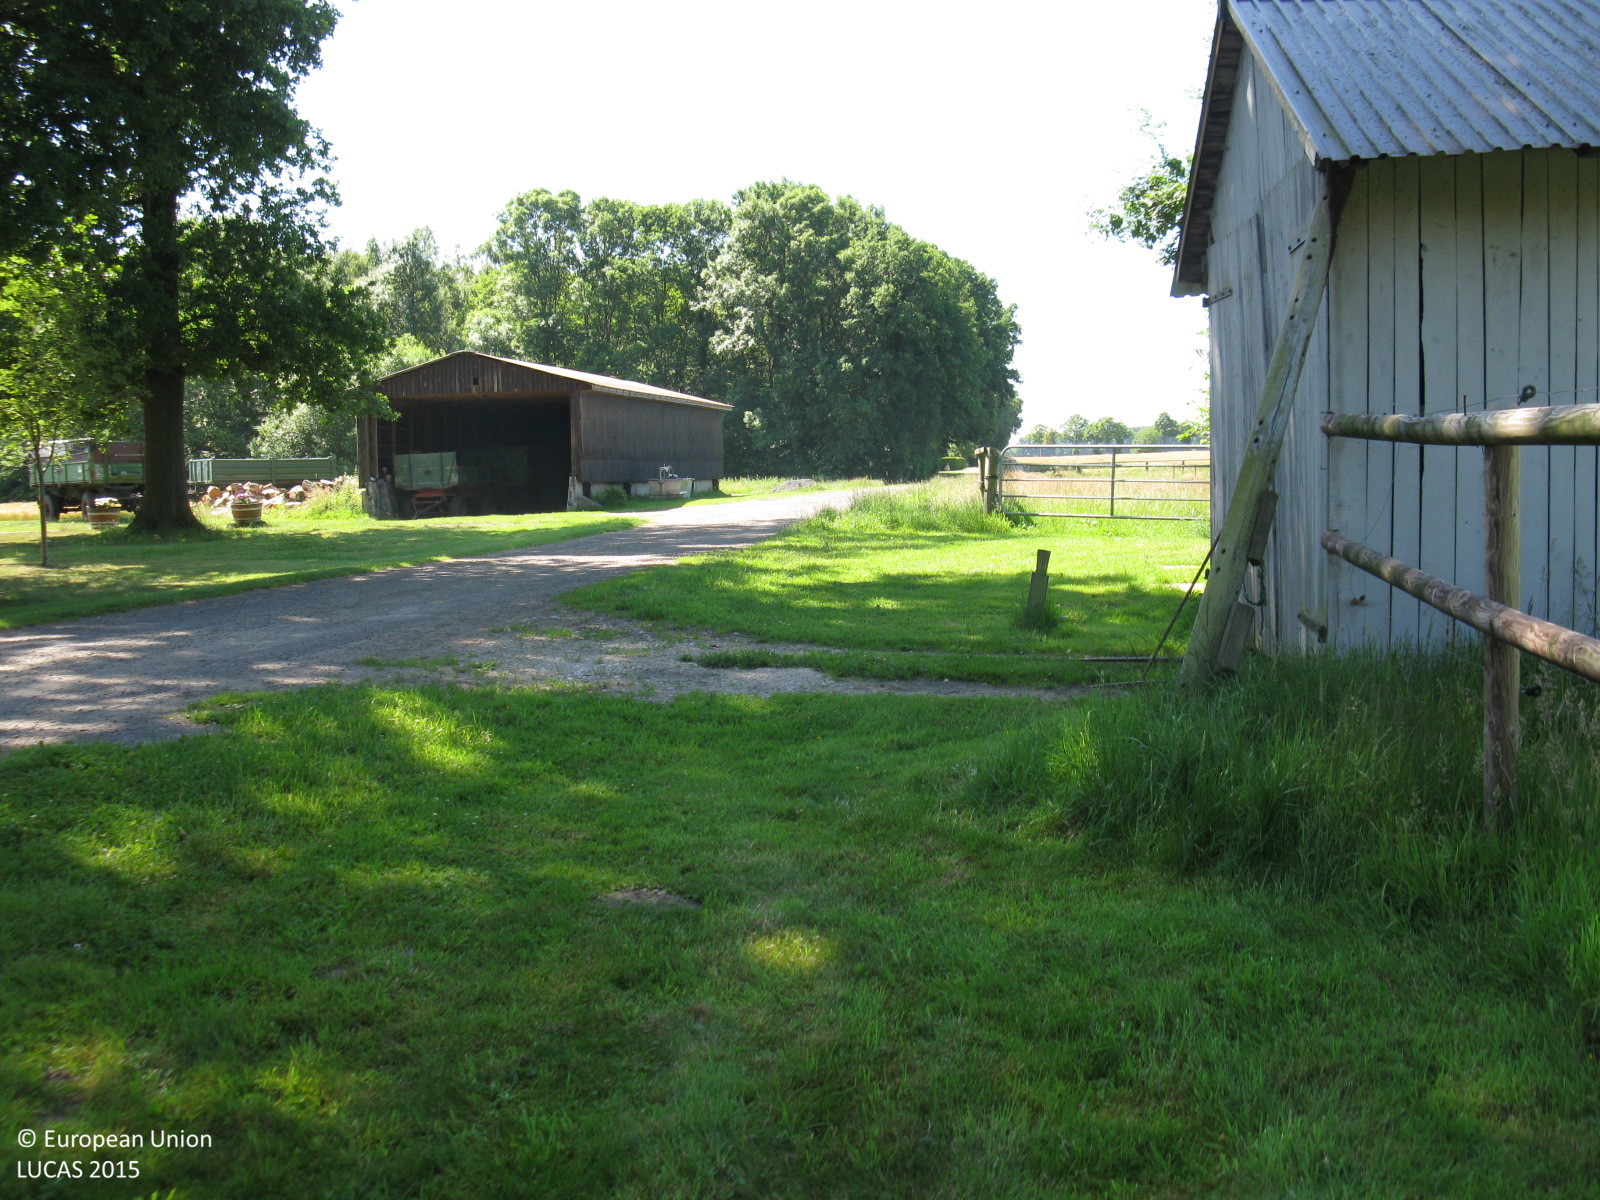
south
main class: Grassland
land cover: Grassland without tree/shrub cover
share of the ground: > 75 %
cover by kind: herbaceous plants 100 %
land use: Agriculture (excluding fallow land and kitchen gardens)
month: June
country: DE
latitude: 52.8717
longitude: 8.5297
